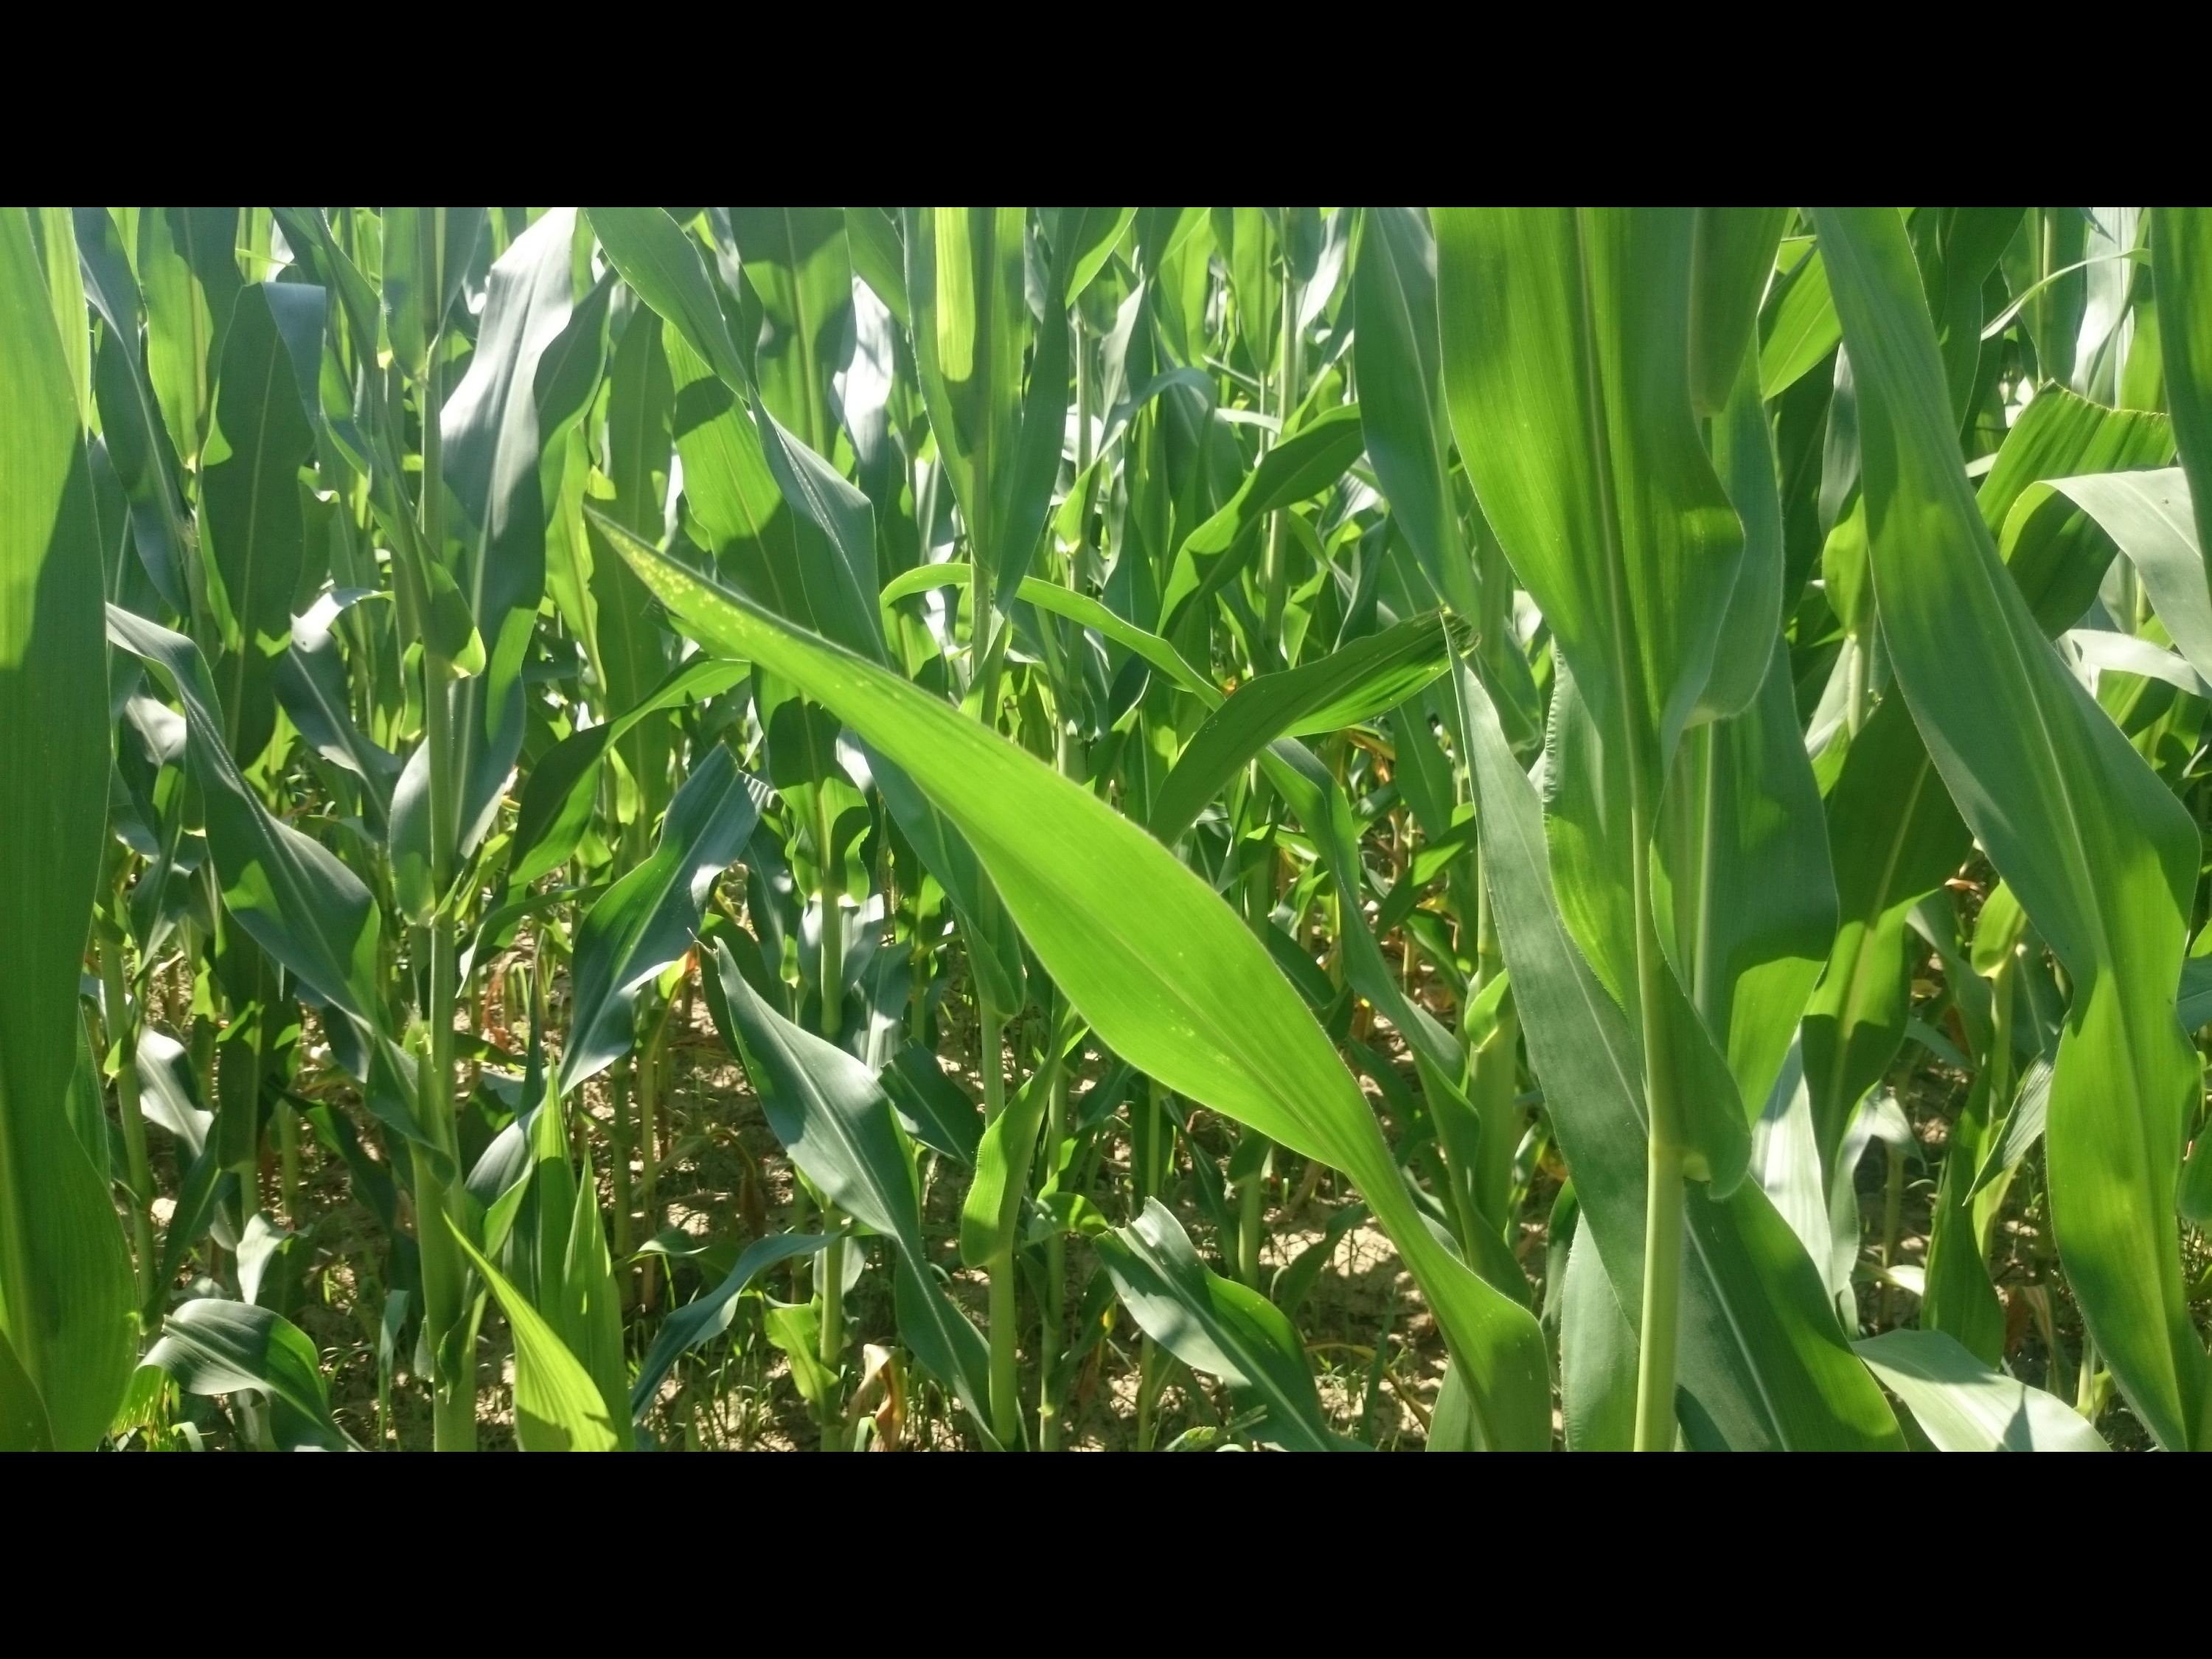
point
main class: Cropland
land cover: Maize
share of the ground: > 75 %
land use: Agriculture (excluding fallow land and kitchen gardens)
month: July
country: AT
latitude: 47.0127
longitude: 16.0126
